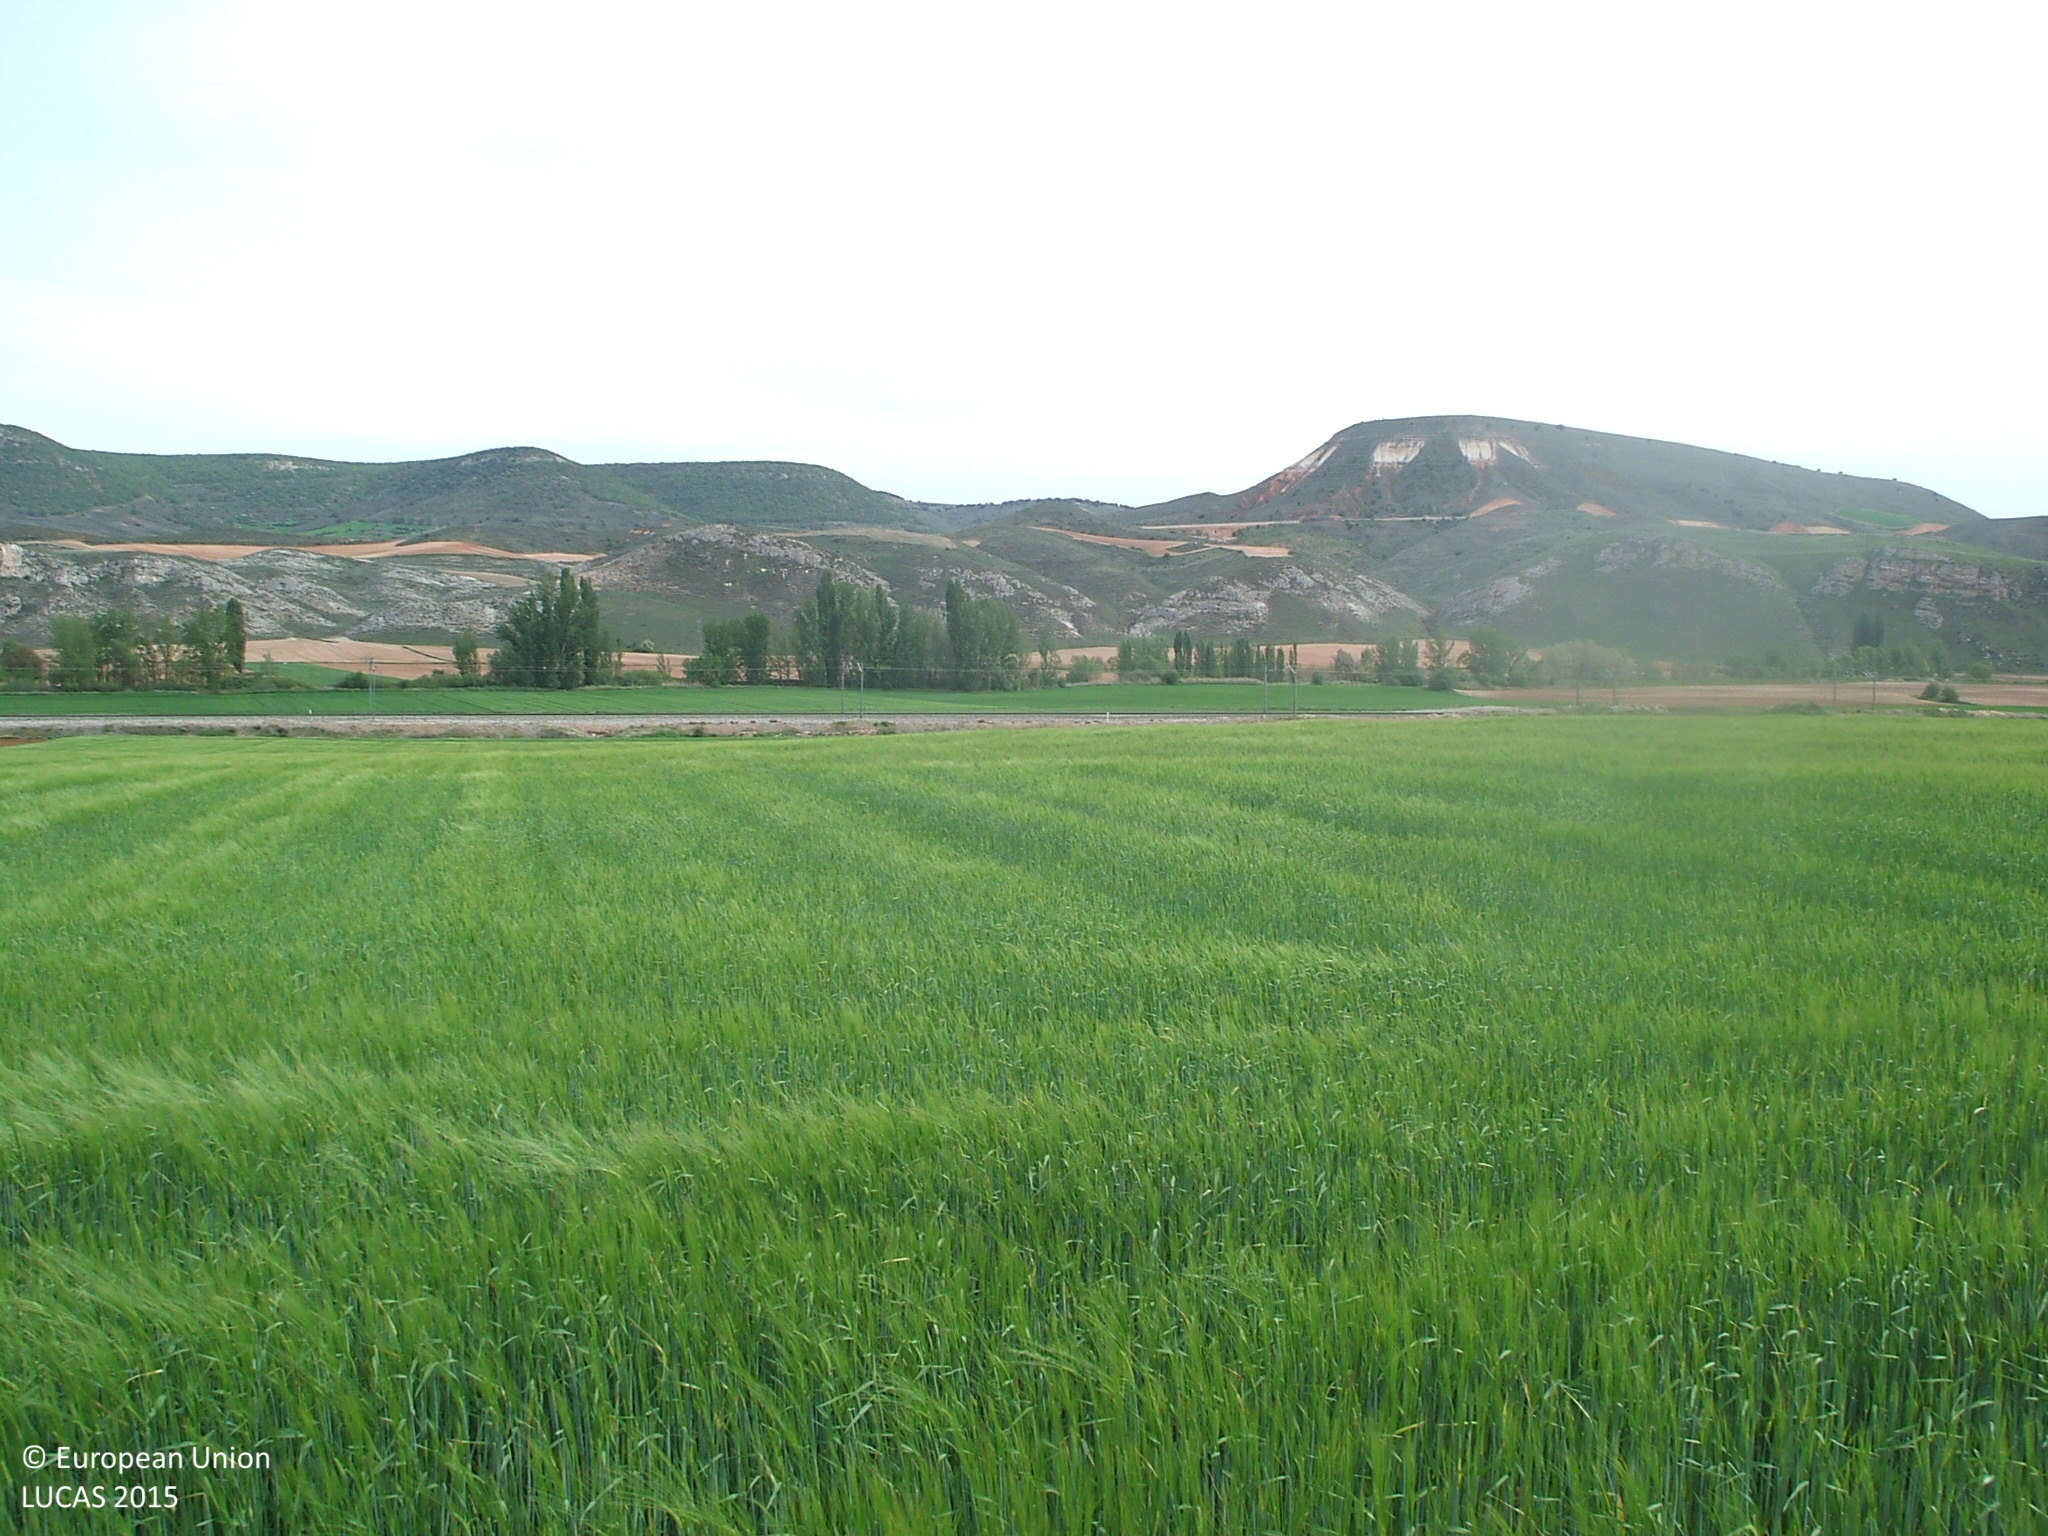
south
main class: Cropland
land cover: Barley
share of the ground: > 75 %
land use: Agriculture (excluding fallow land and kitchen gardens)
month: May
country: ES
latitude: 40.9483
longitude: -2.8992
